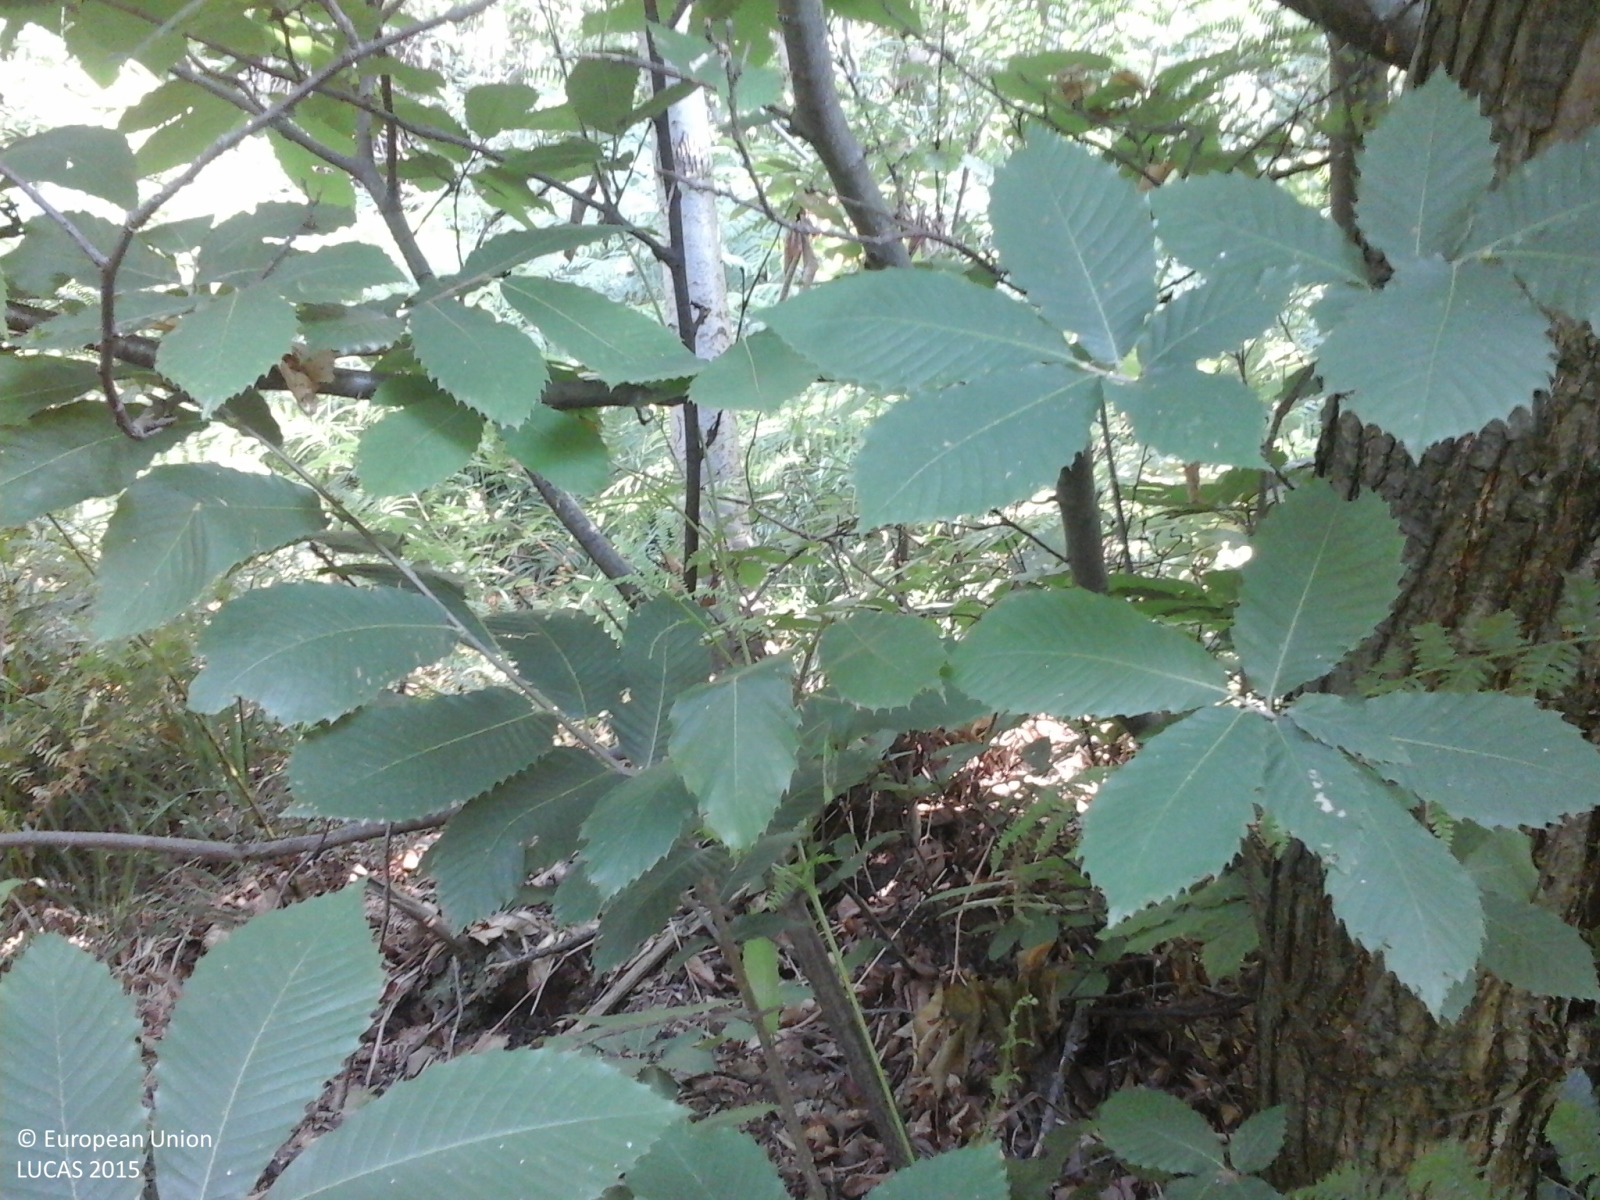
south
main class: Woodland
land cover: Broadleaved woodland
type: thermophilous deciduous forest
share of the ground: > 75 %
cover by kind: broadleaved forest trees 100 %
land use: Semi-natural and natural areas not in use
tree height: > 5 m
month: July
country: IT
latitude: 44.8563
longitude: 7.2842
